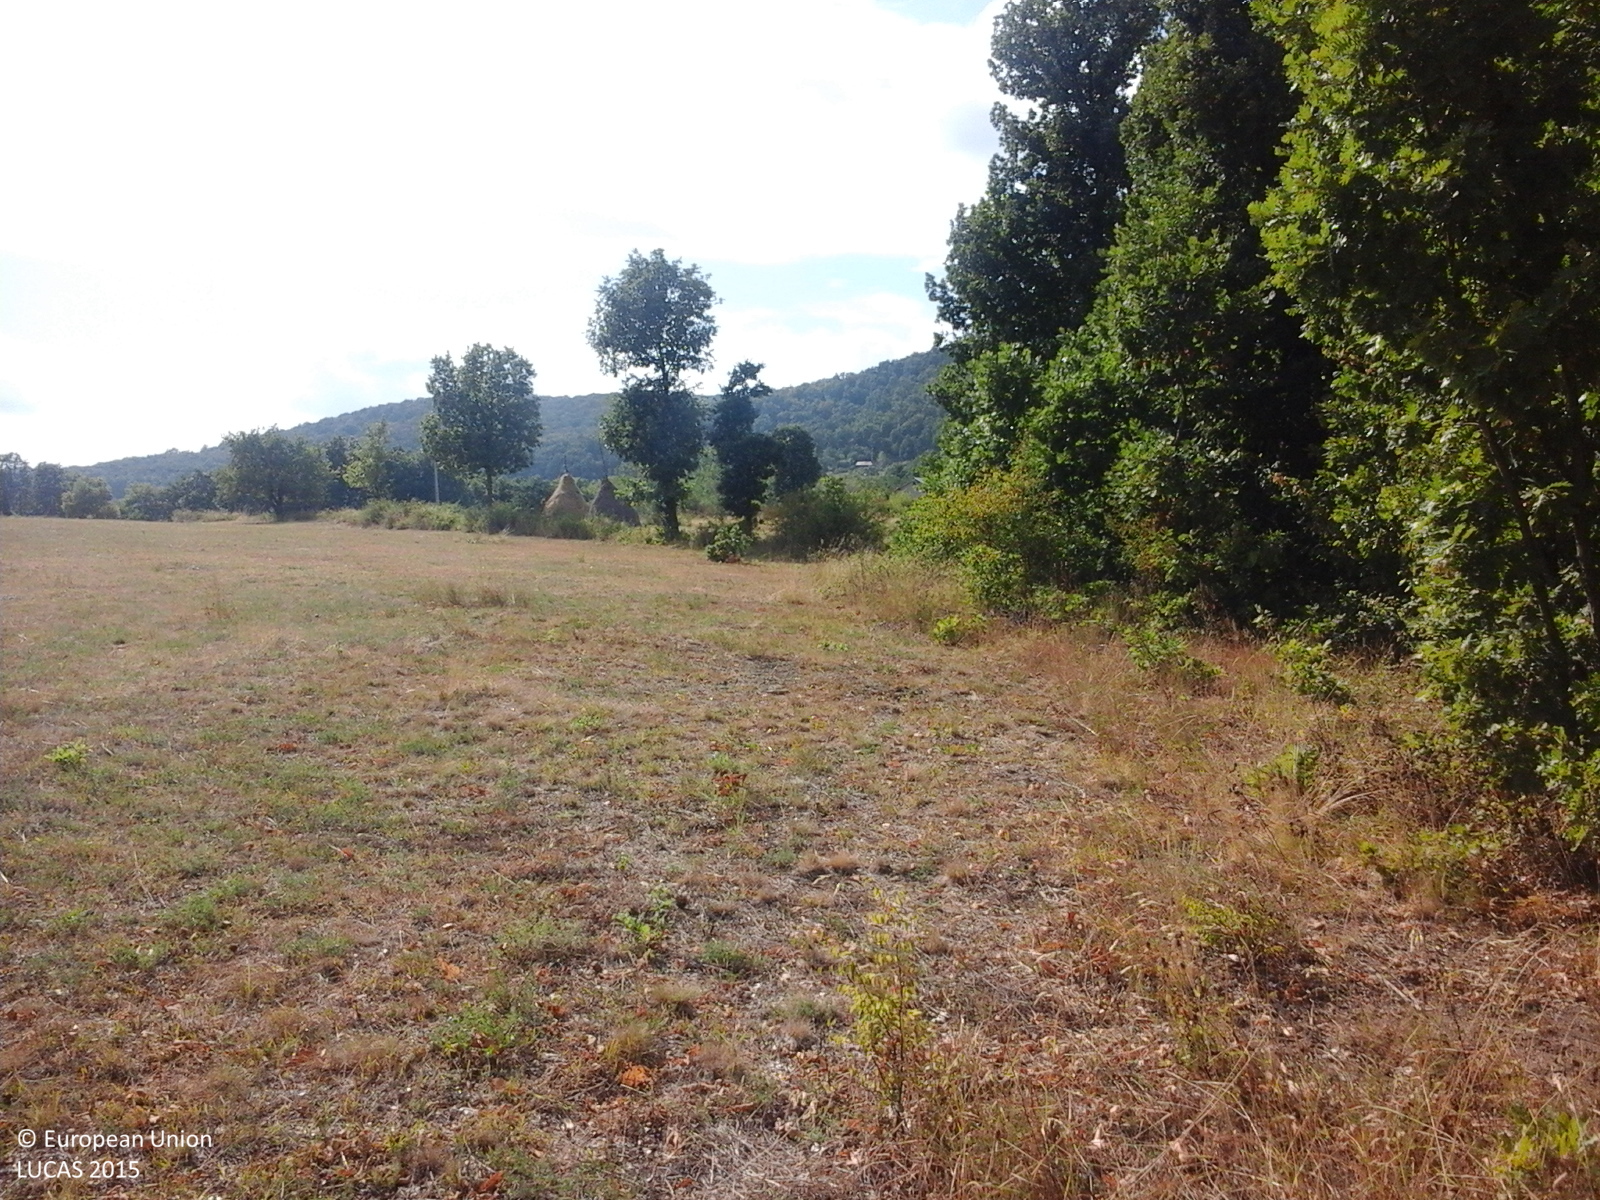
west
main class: Woodland
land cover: Broadleaved woodland
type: acidophilous oak and oak-birch forest
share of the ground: > 75 %
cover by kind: broadleaved forest trees 100 %
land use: Forestry
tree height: > 5 m
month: August
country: RO
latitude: 44.7632
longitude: 22.4589
